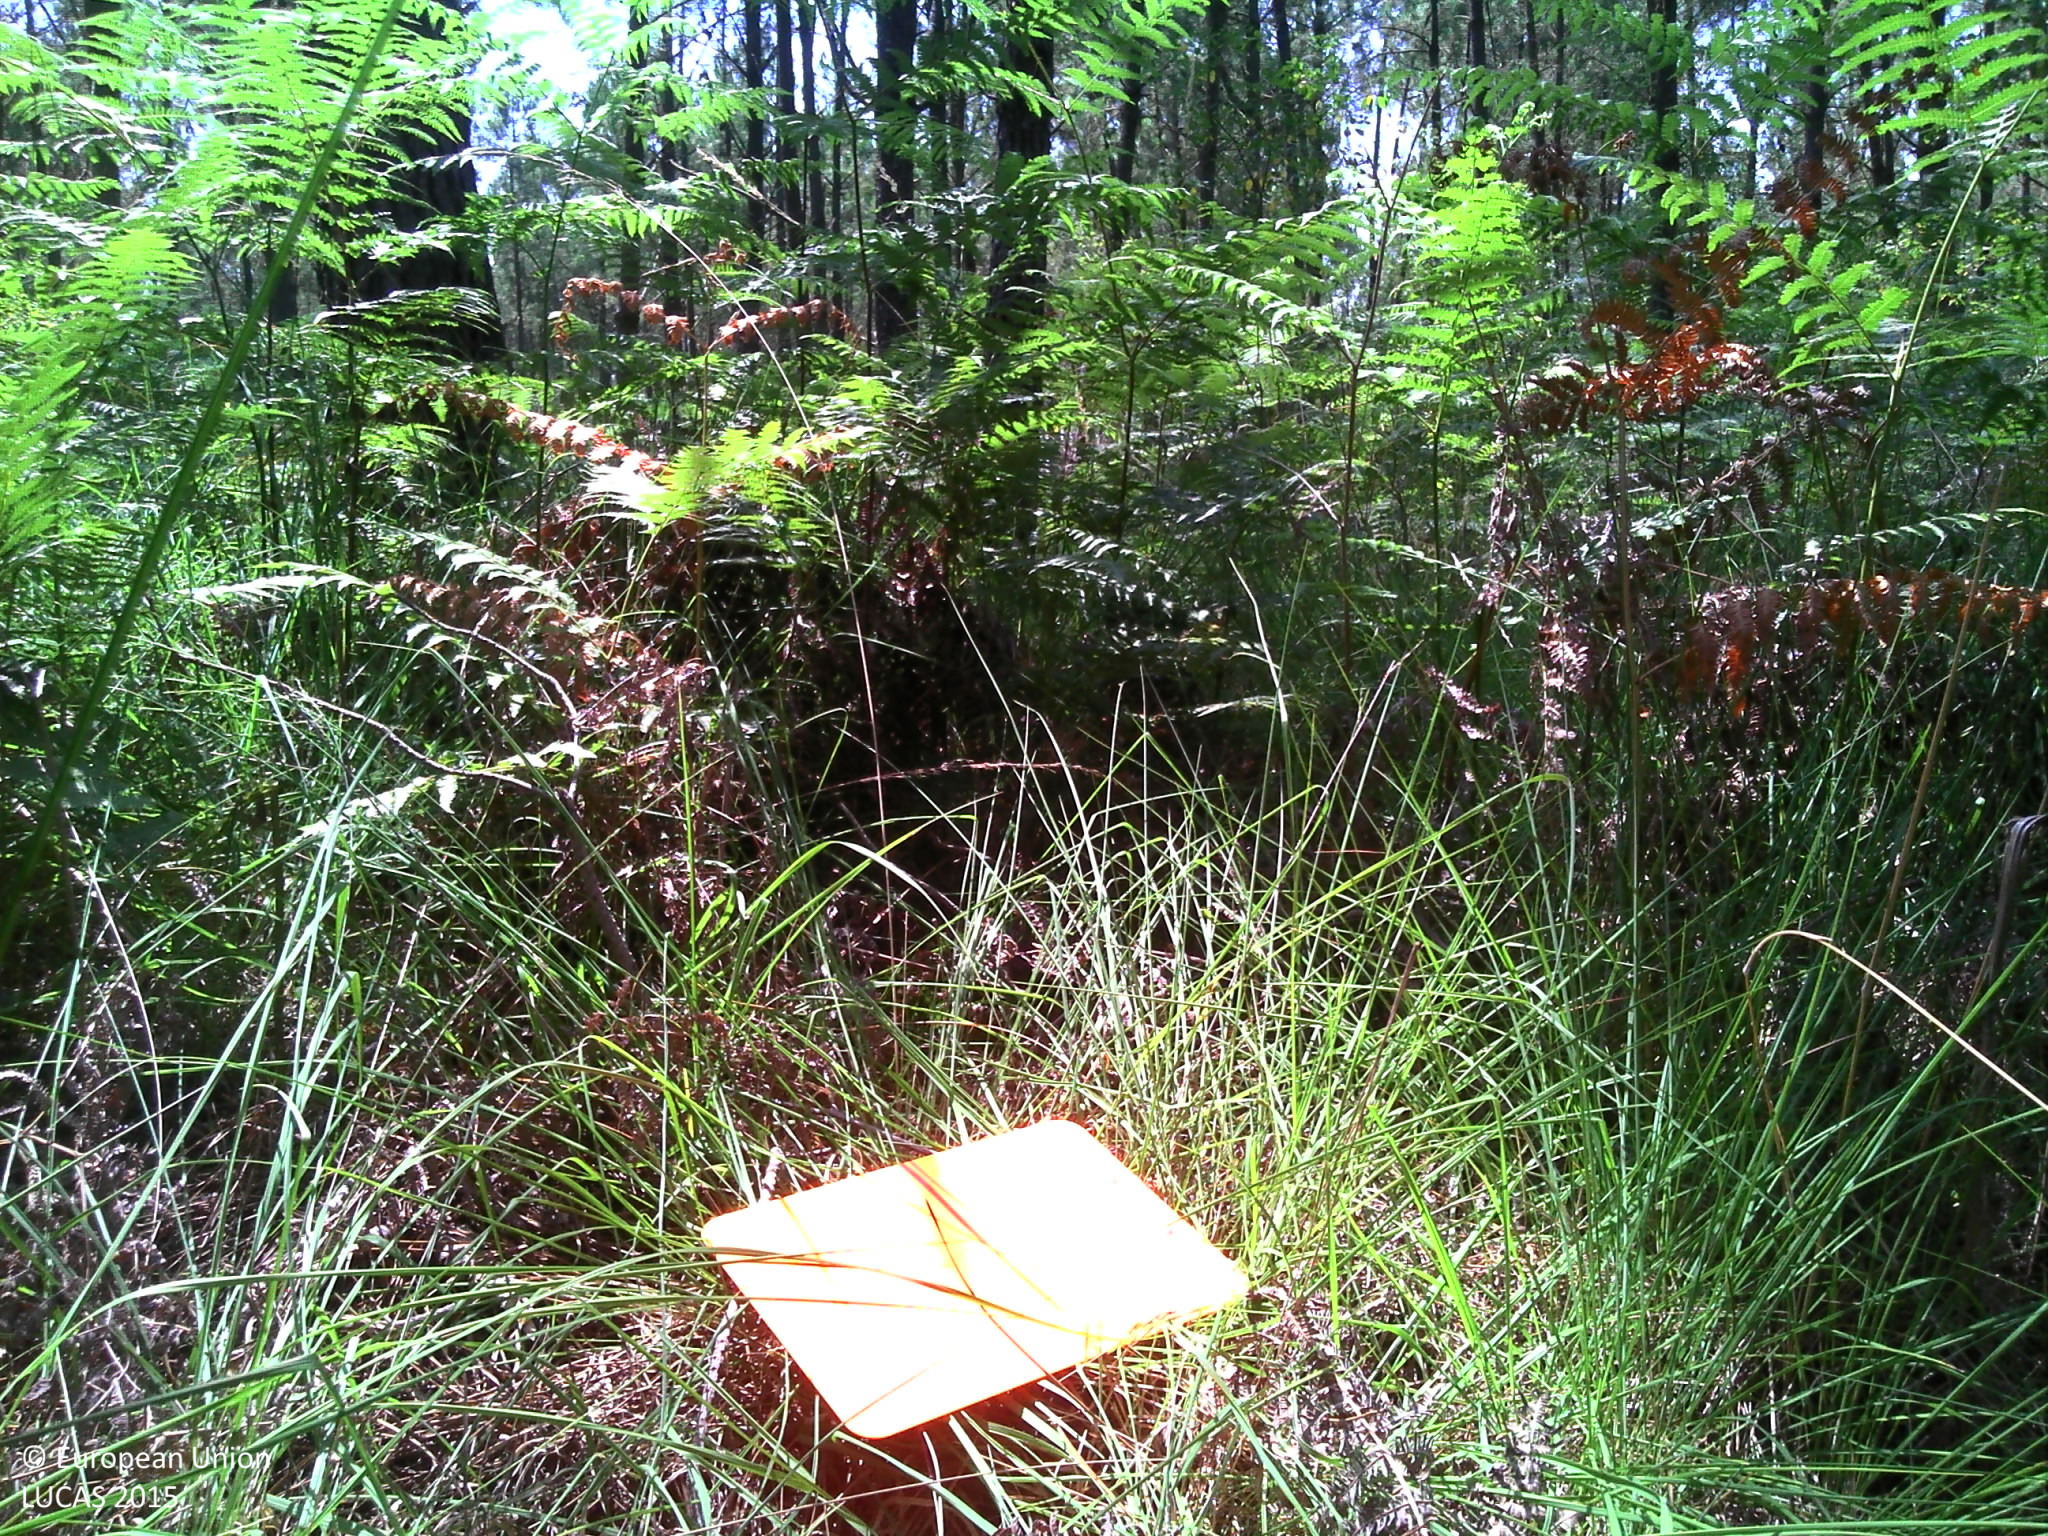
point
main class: Woodland
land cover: Pine dominated coniferous woodland
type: coniferous forest of the mediterranean region
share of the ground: > 75 %
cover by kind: coniferous forest trees 75 %, herbaceous plants 20 %, shrubs 5 %
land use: Forestry
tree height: > 5 m
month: July
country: FR
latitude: 44.2733
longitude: -0.6525
